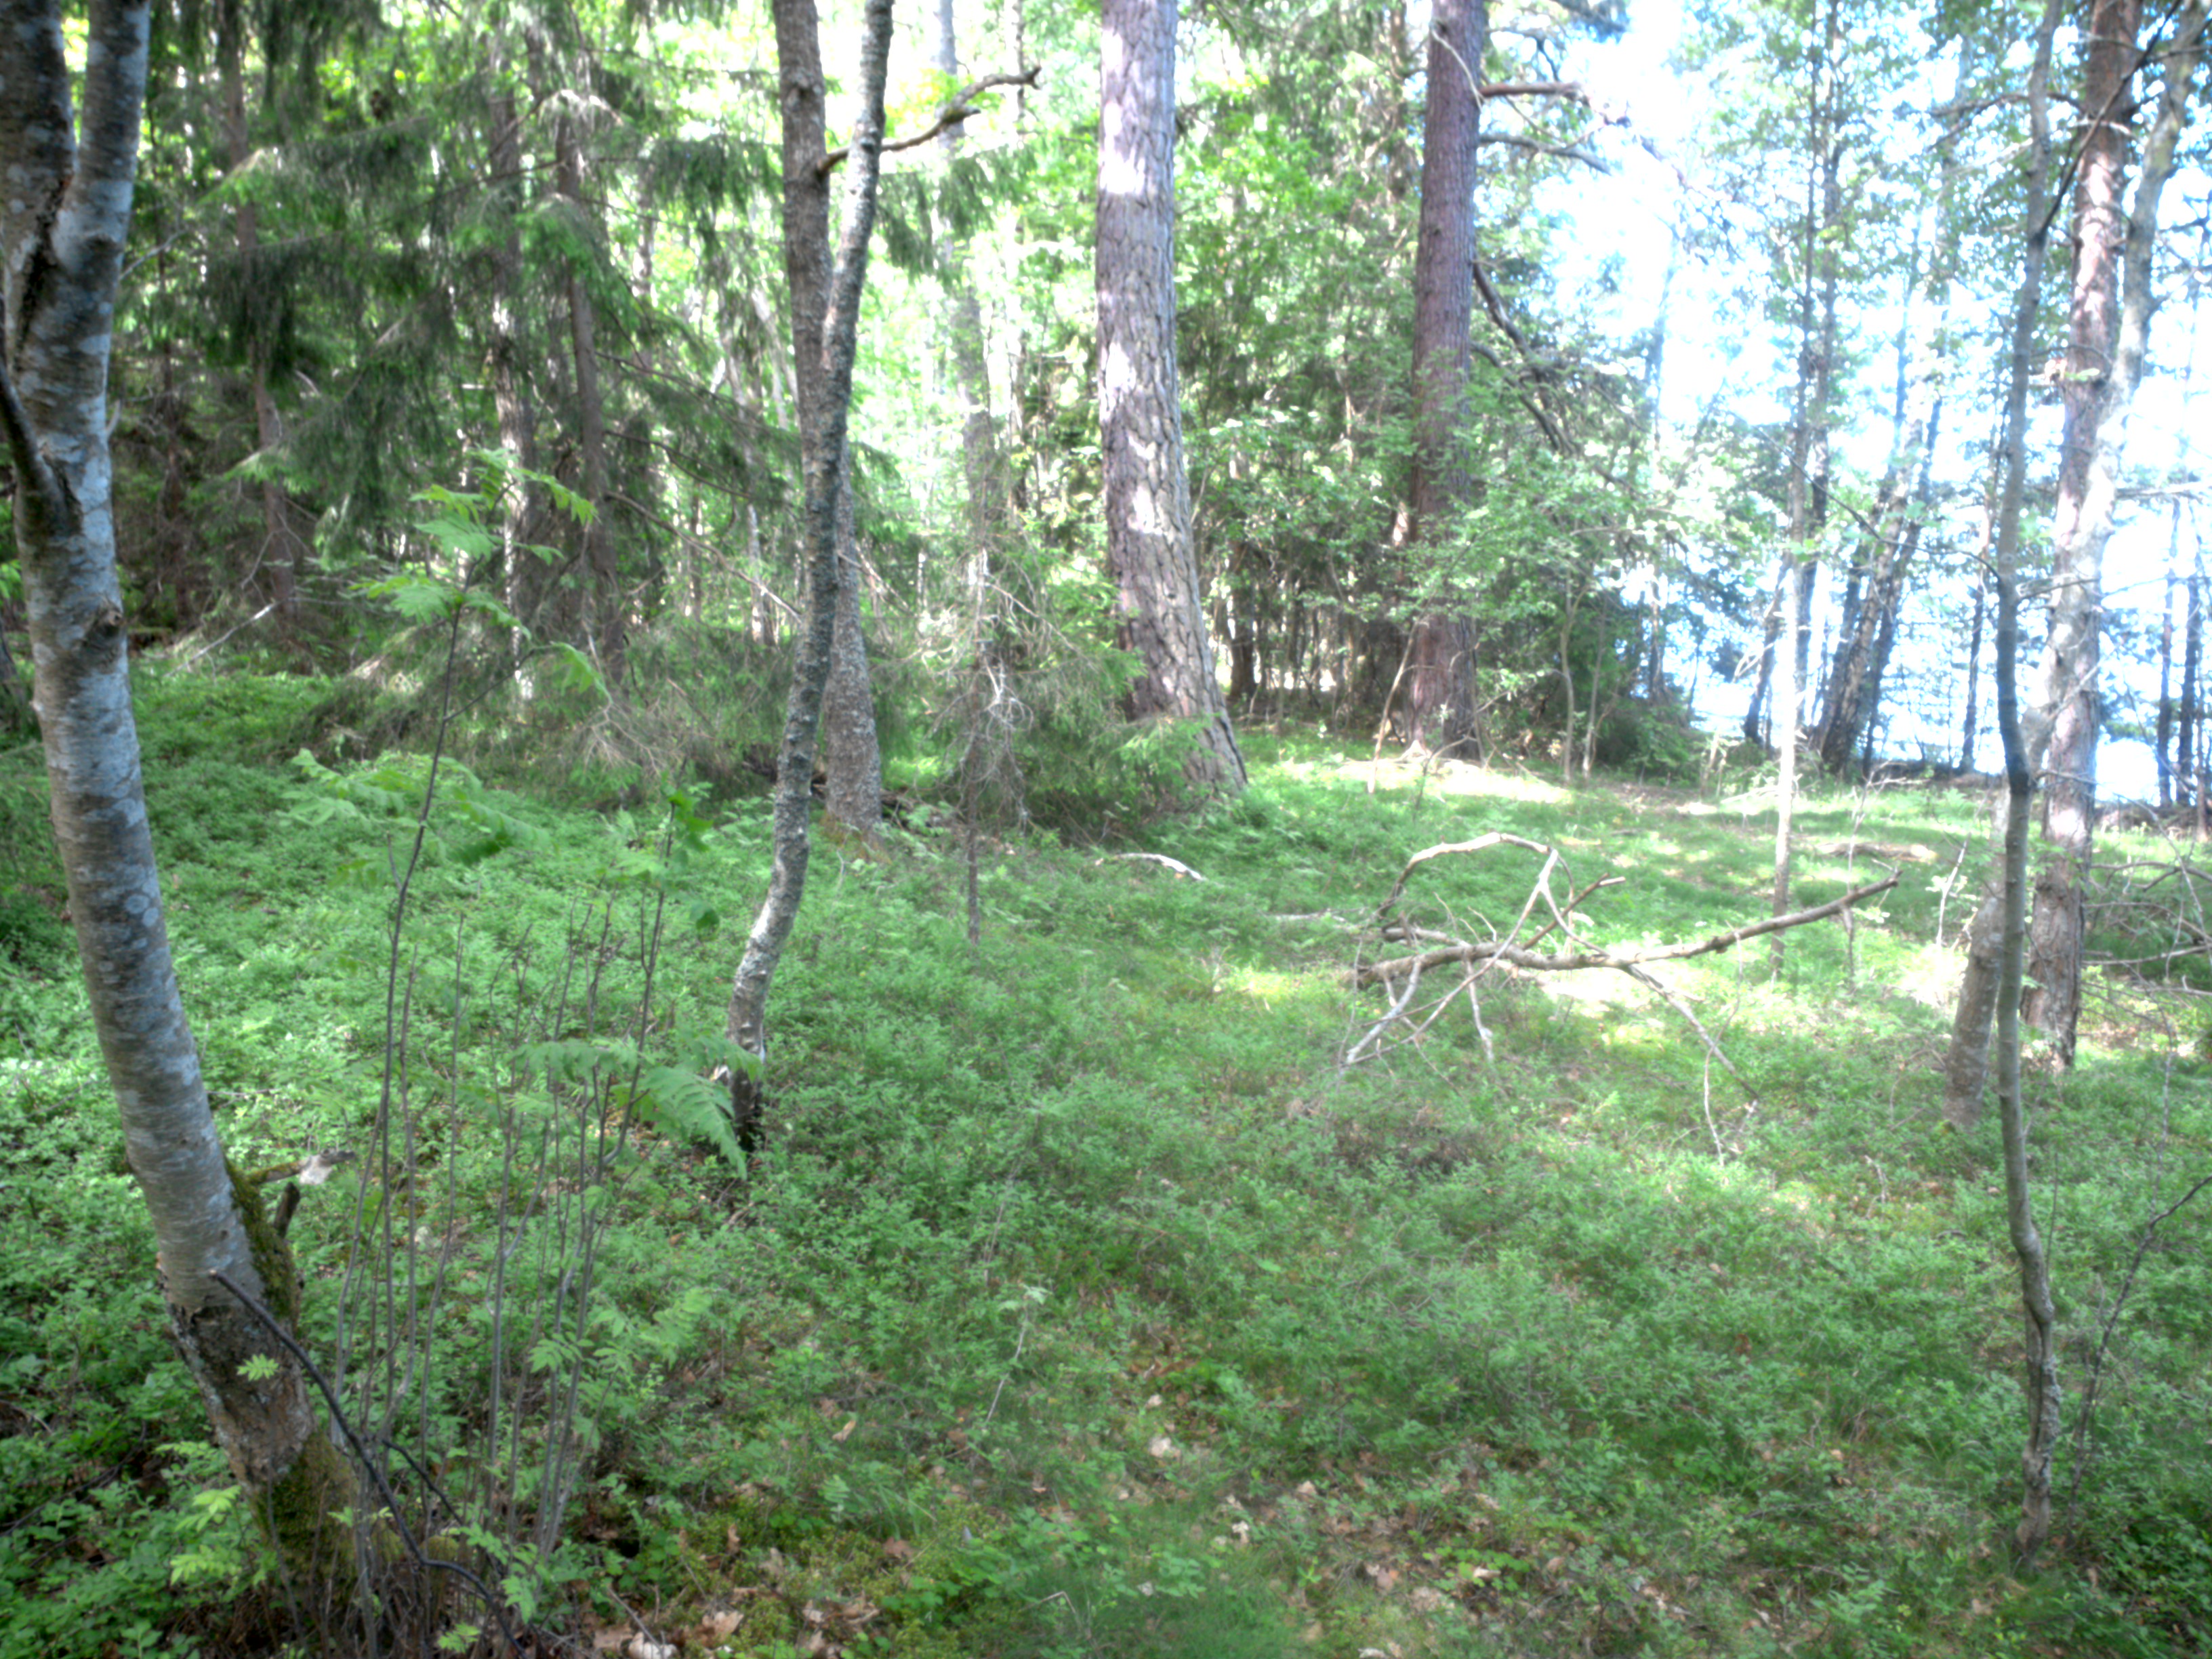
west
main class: Woodland
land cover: Broadleaved woodland
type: non-riverine alder, birch or aspen forest
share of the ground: > 75 %
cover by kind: broadleaved forest trees 80 %, coniferous forest trees 10 %, shrubs 5 %, herbaceous plants 5 %
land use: Forestry
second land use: Amenities, museums, leisure
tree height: > 5 m
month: June
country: SE
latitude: 59.3202
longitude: 17.6754
